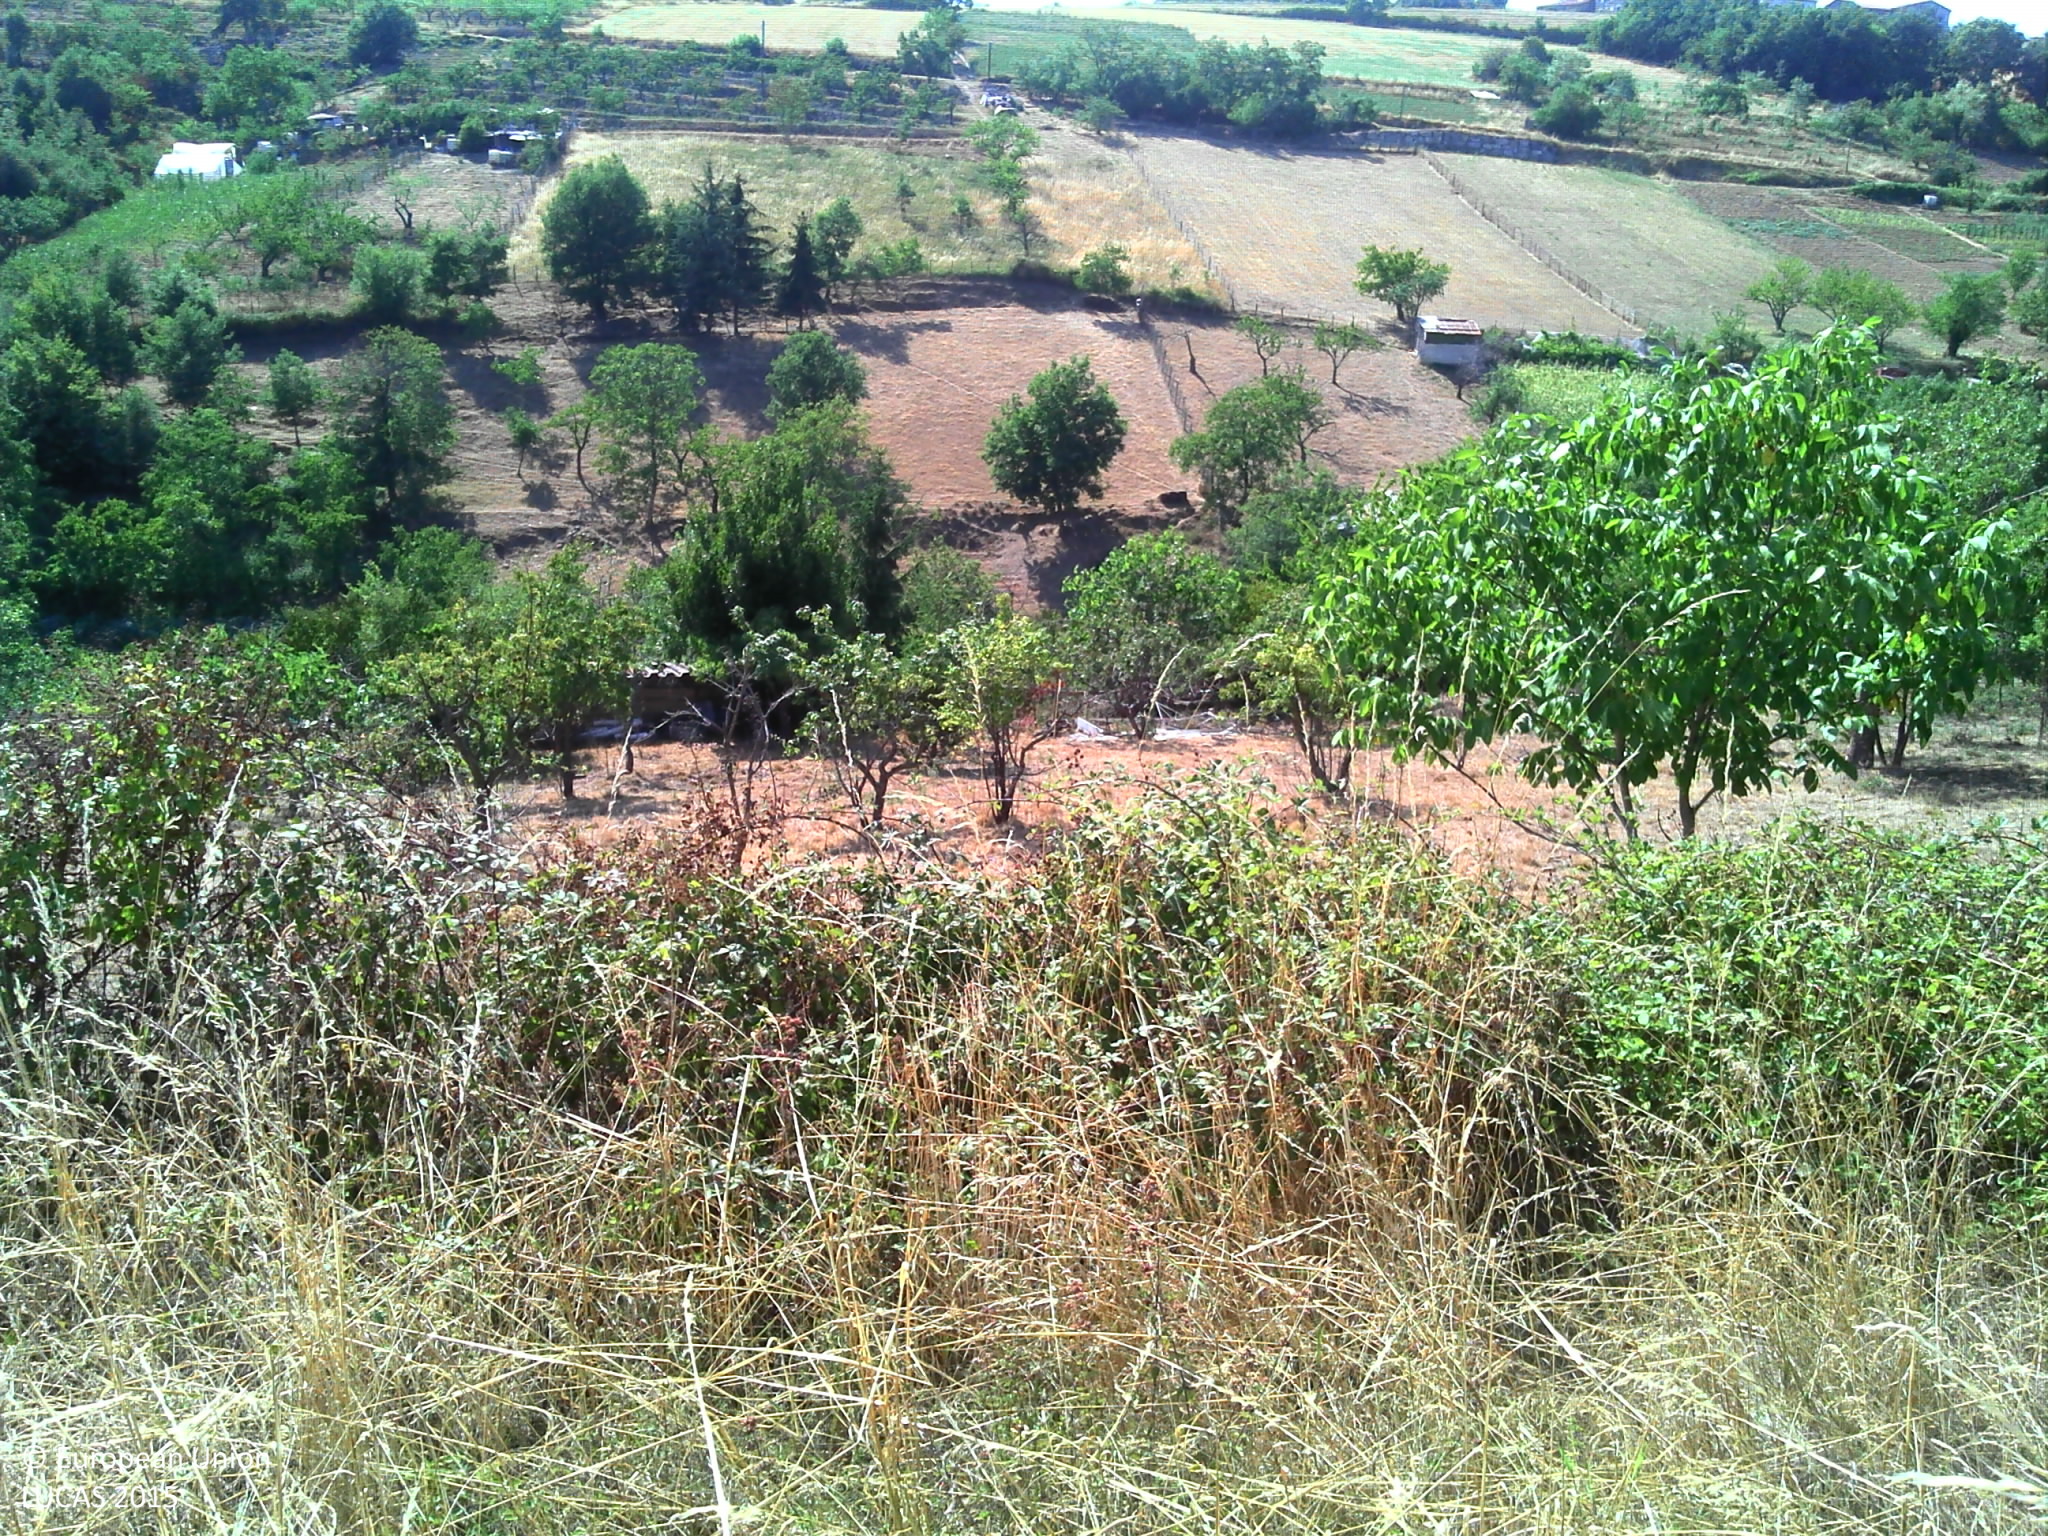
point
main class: Cropland
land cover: Apple fruit
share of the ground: 10 - 25 %
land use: Agriculture (excluding fallow land and kitchen gardens)
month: August
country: FR
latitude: 45.5461
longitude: 4.5860
